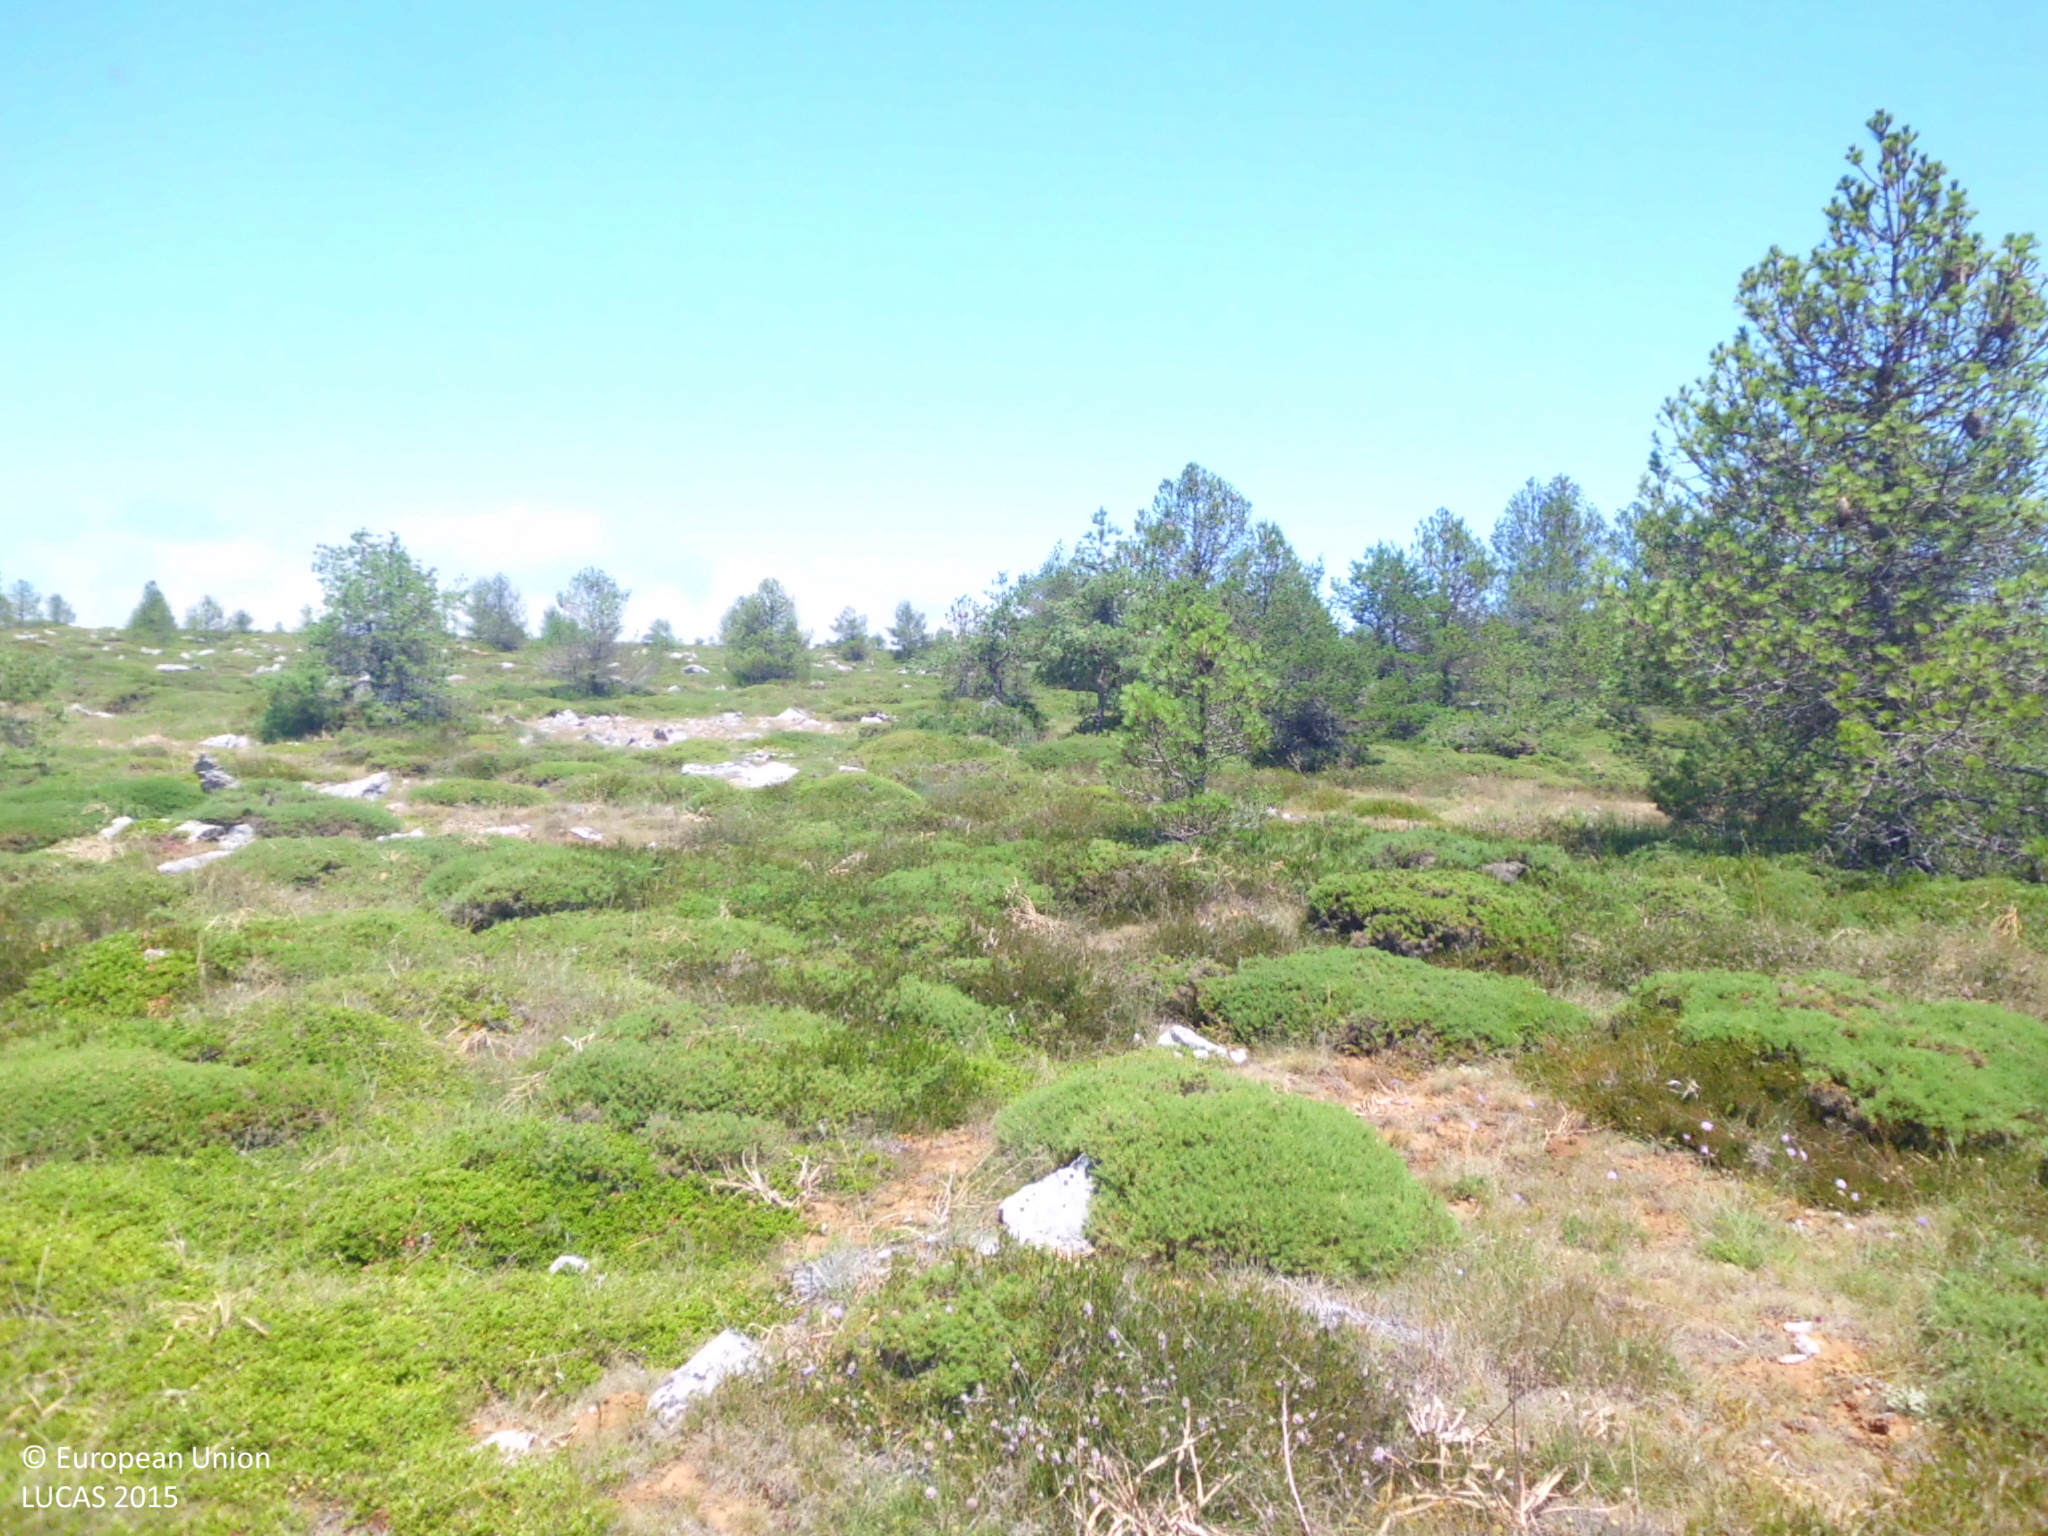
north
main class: Shrubland
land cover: Shrubland with sparse tree cover
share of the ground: 50 - 75 %
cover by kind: shrubs 50 %, consolidated bare surface 25 %, herbaceous plants 20 %, coniferous forest trees 5 %
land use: Semi-natural and natural areas not in use
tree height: < 5 m
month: July
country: ES
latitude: 42.7763
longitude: -4.1155
